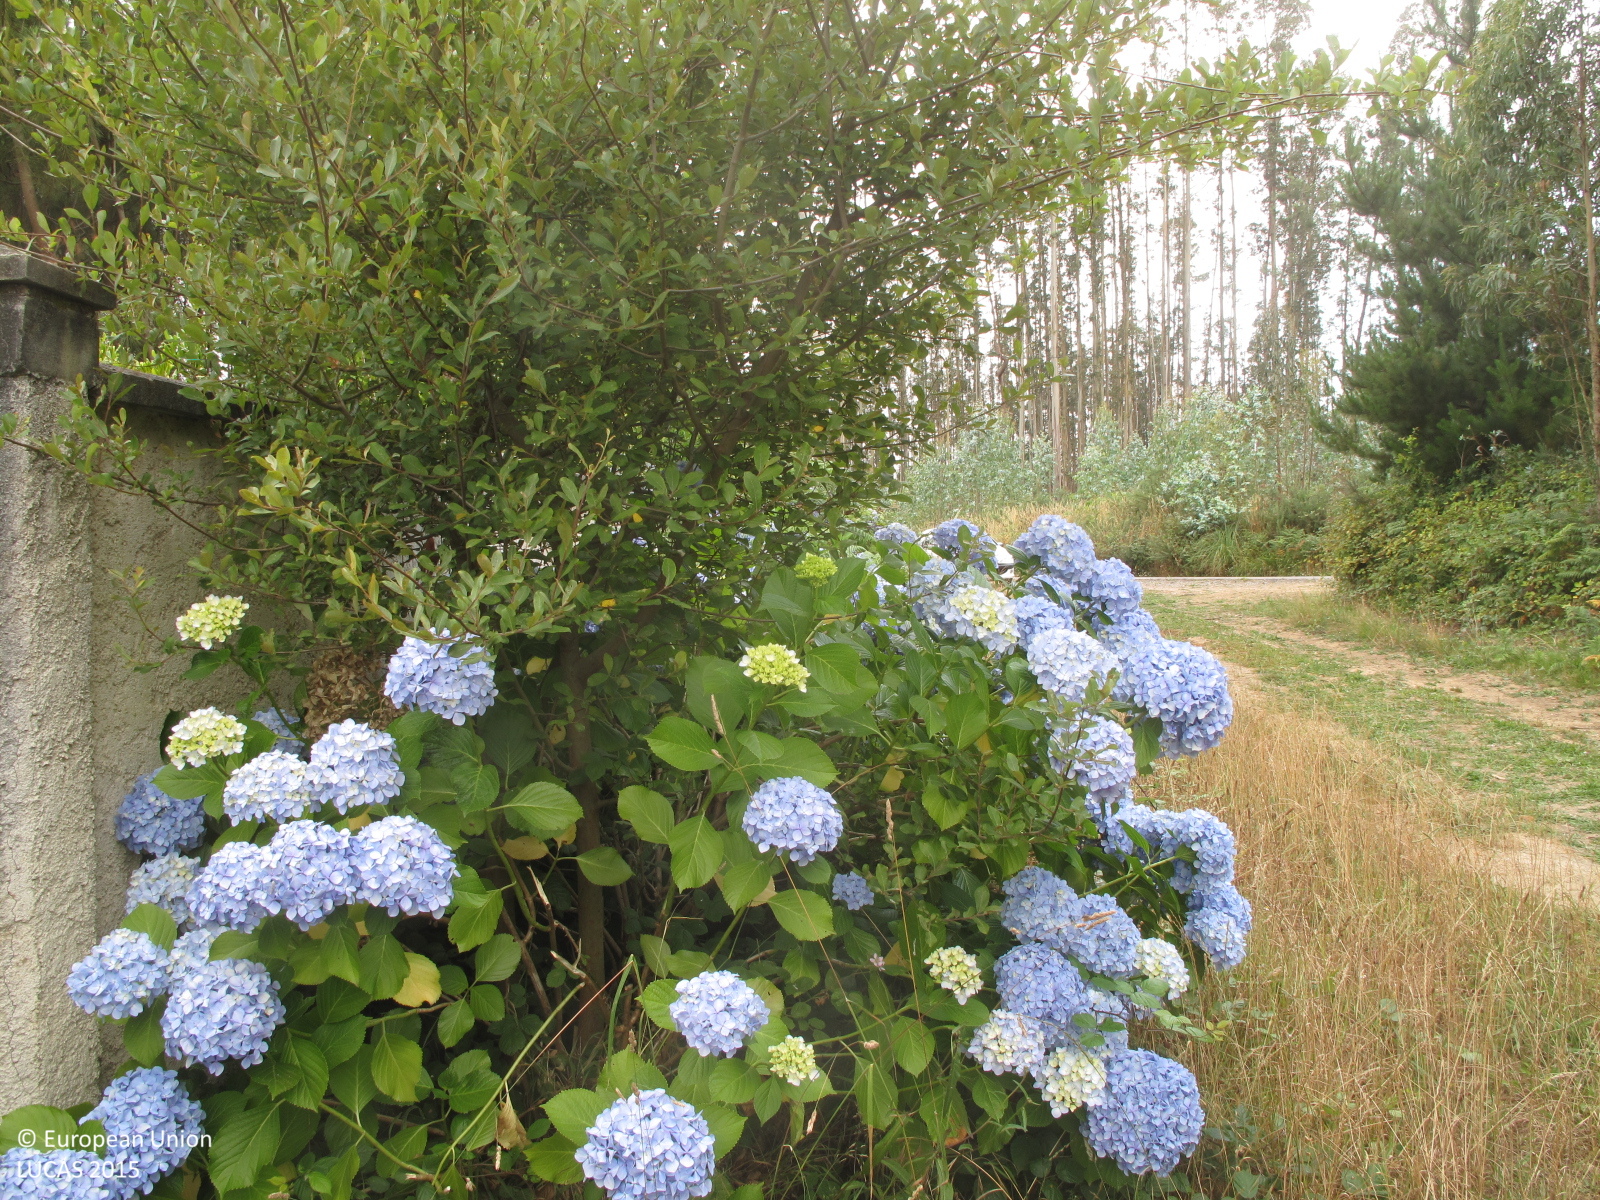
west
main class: Grassland
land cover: Grassland with sparse tree/shrub cover
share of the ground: > 75 %
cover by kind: herbaceous plants 95 %, broadleaved forest trees 5 %
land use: Residential
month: July
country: ES
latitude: 43.2996
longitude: -8.2842
